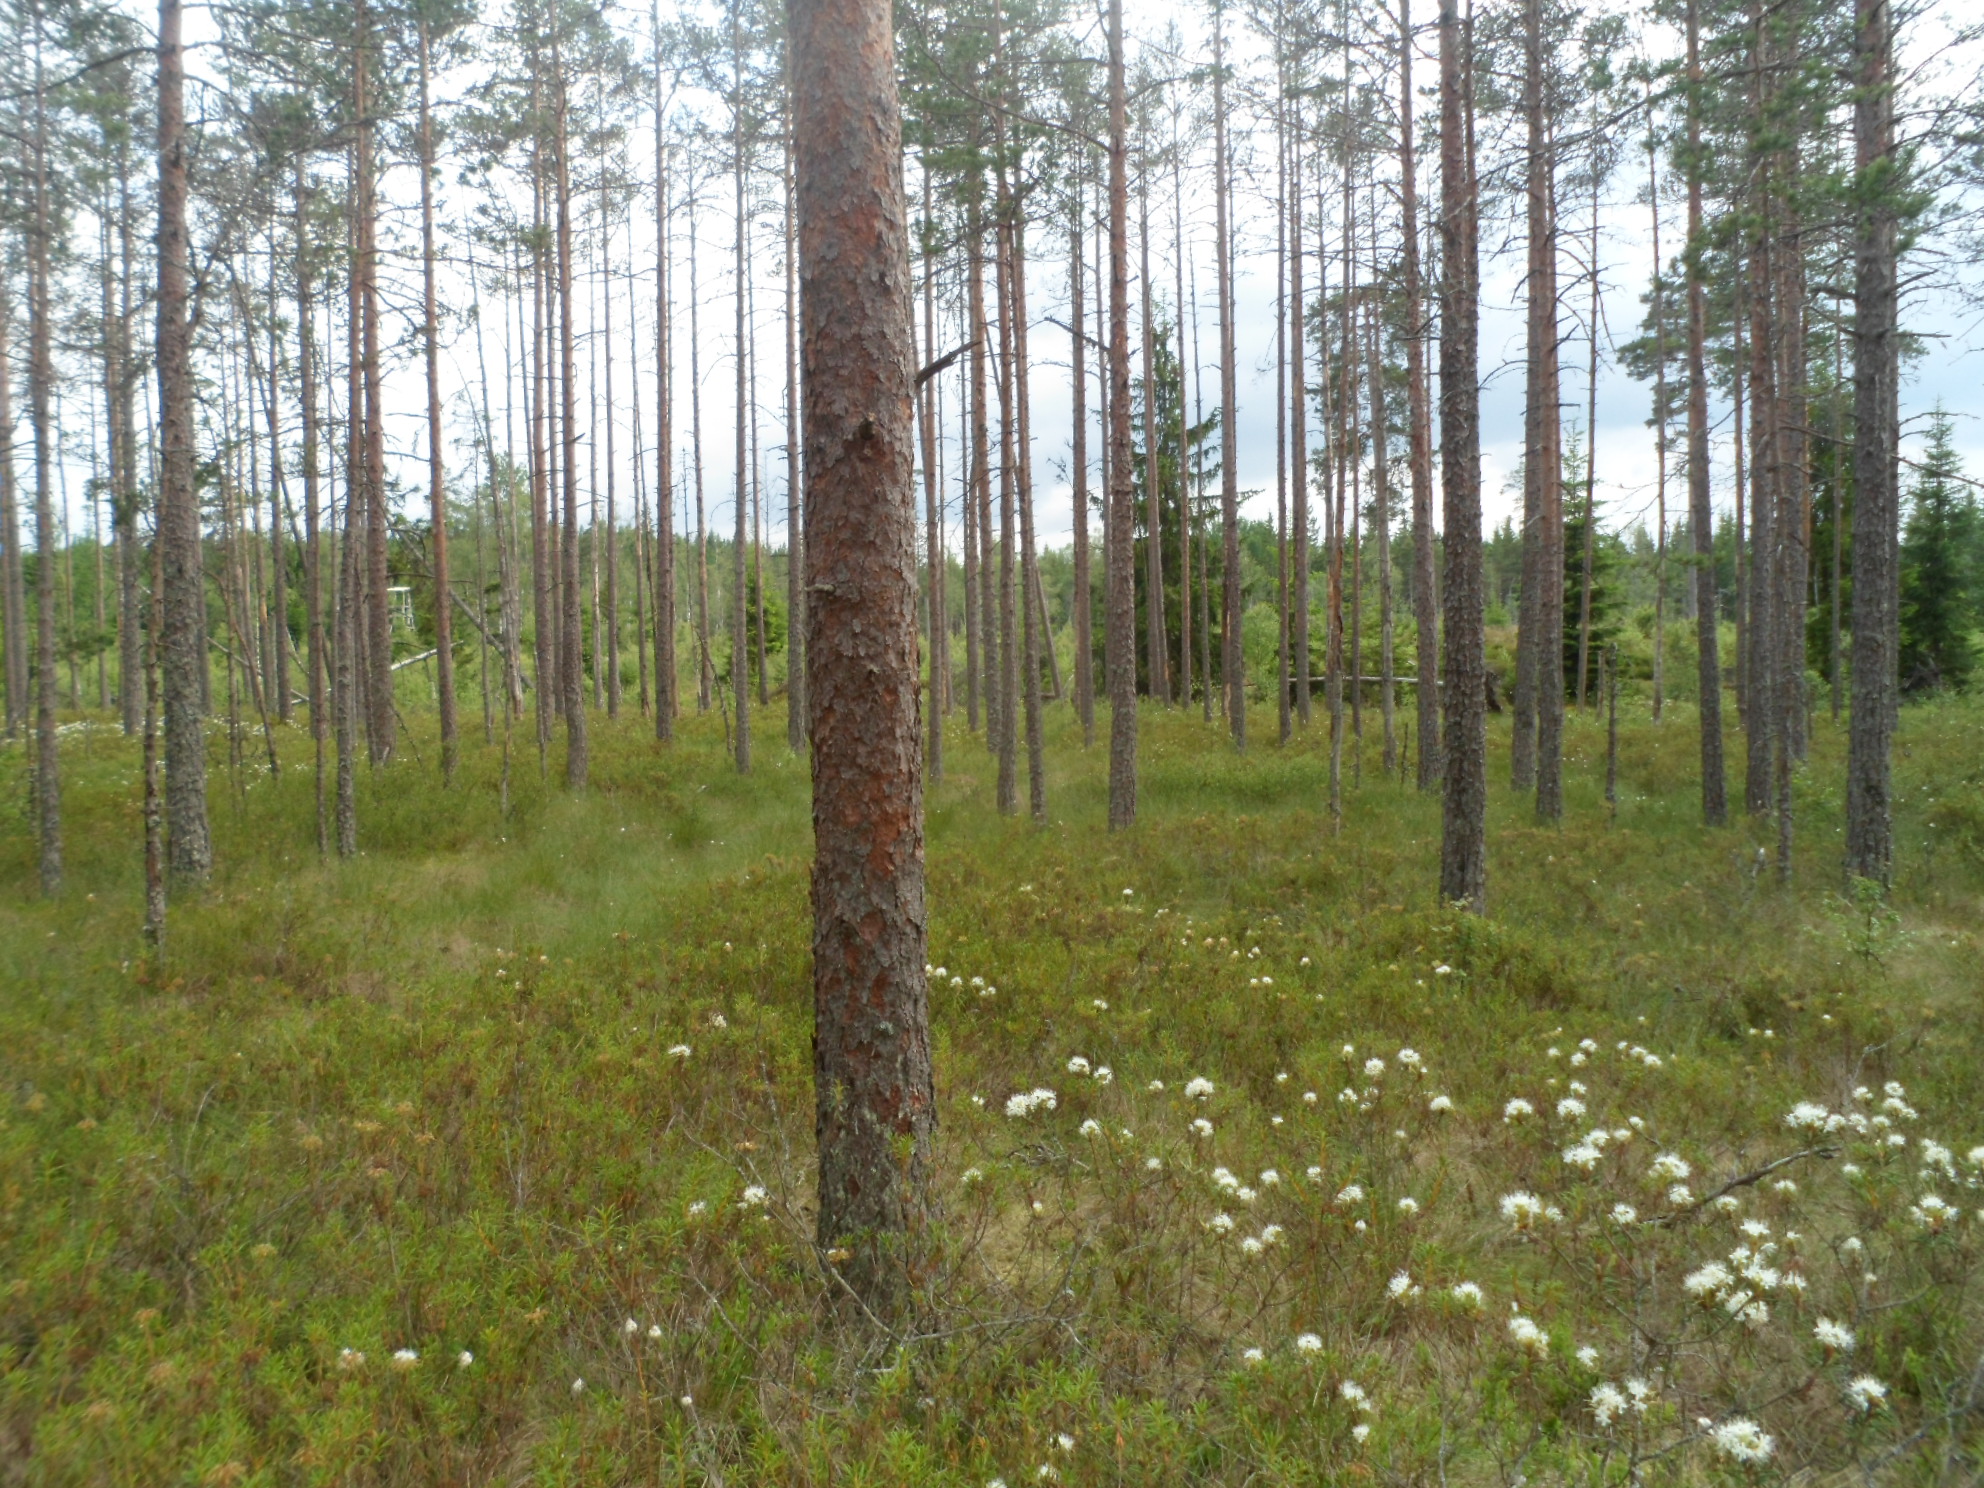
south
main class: Woodland
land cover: Pine dominated coniferous woodland
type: boreal forest
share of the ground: 25 - 50 %
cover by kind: coniferous forest trees 50 %, lichens and mosses 25 %, shrubs 20 %, herbaceous plants 5 %
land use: Forestry
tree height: > 5 m
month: June
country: SE
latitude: 57.1334
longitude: 15.4994
